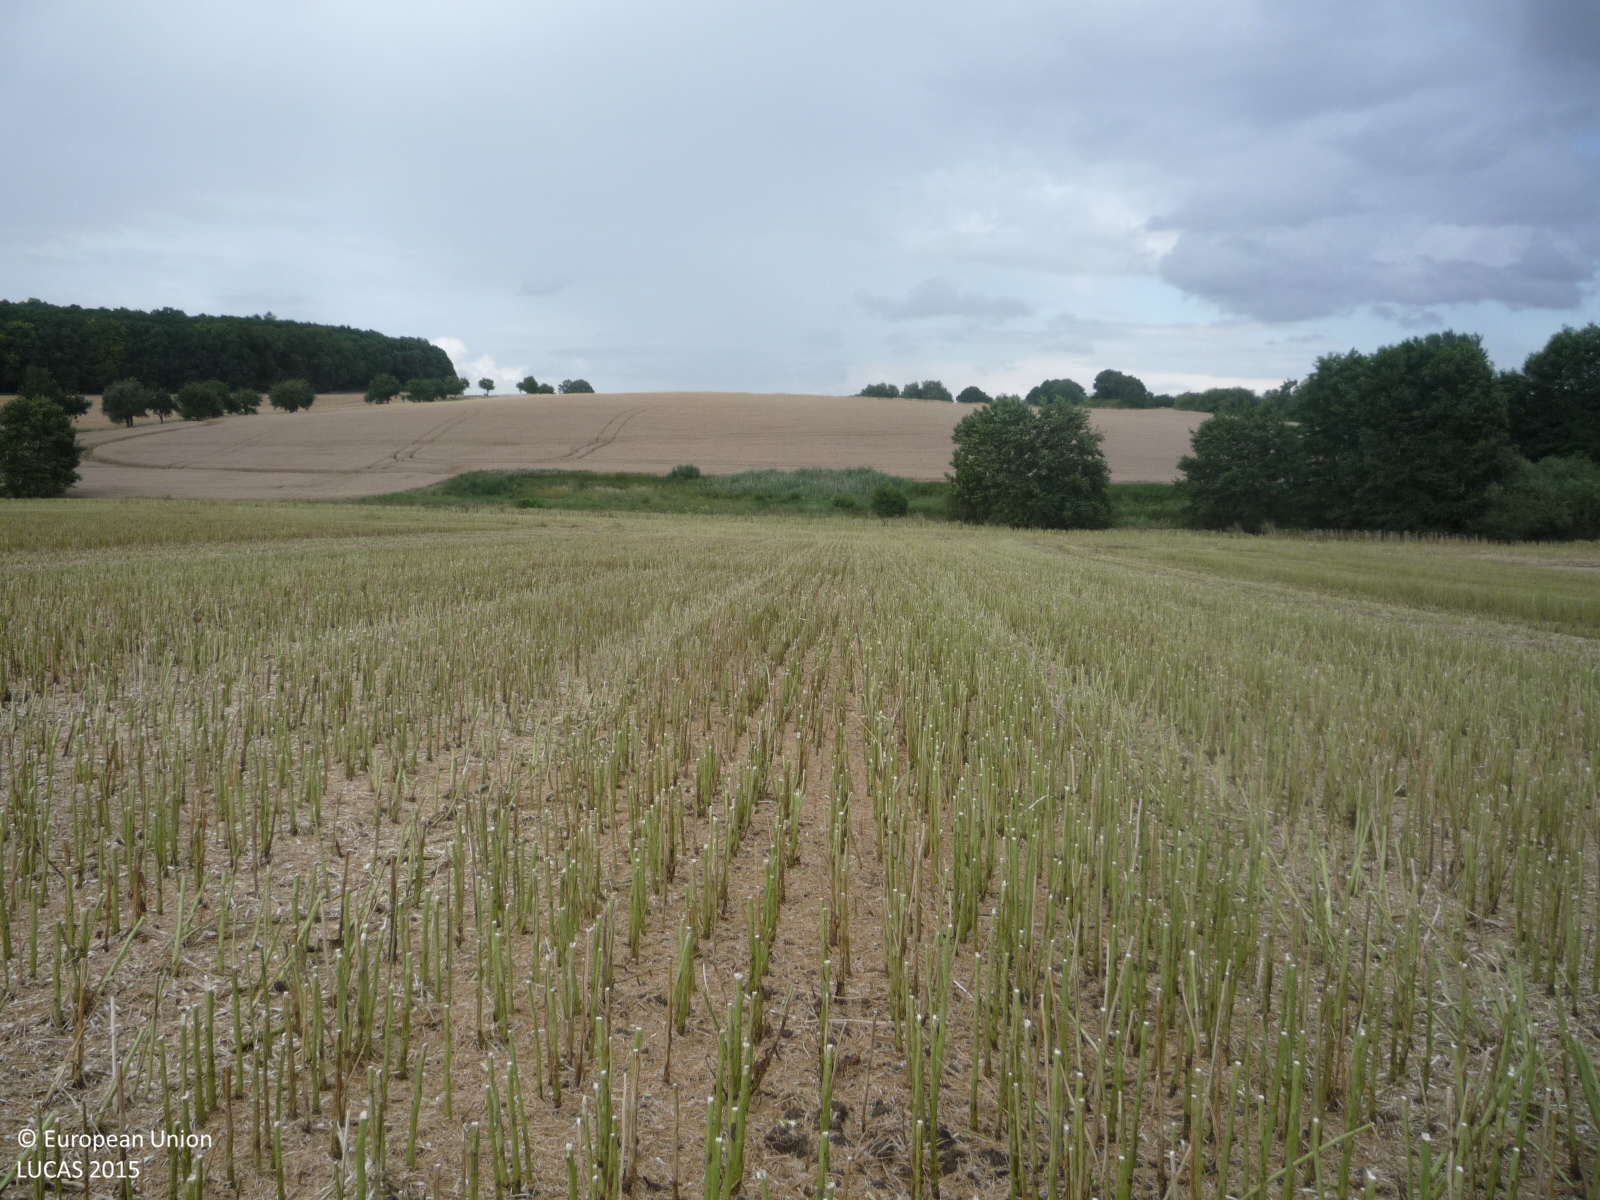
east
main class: Cropland
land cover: Rape and turnip rape
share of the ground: 50 - 75 %
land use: Agriculture (excluding fallow land and kitchen gardens)
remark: Harvested field
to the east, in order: Rape and turnip rape; Spontaneously vegetated surfaces; Common wheat
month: July
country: CZ
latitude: 50.3685
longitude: 15.2757
